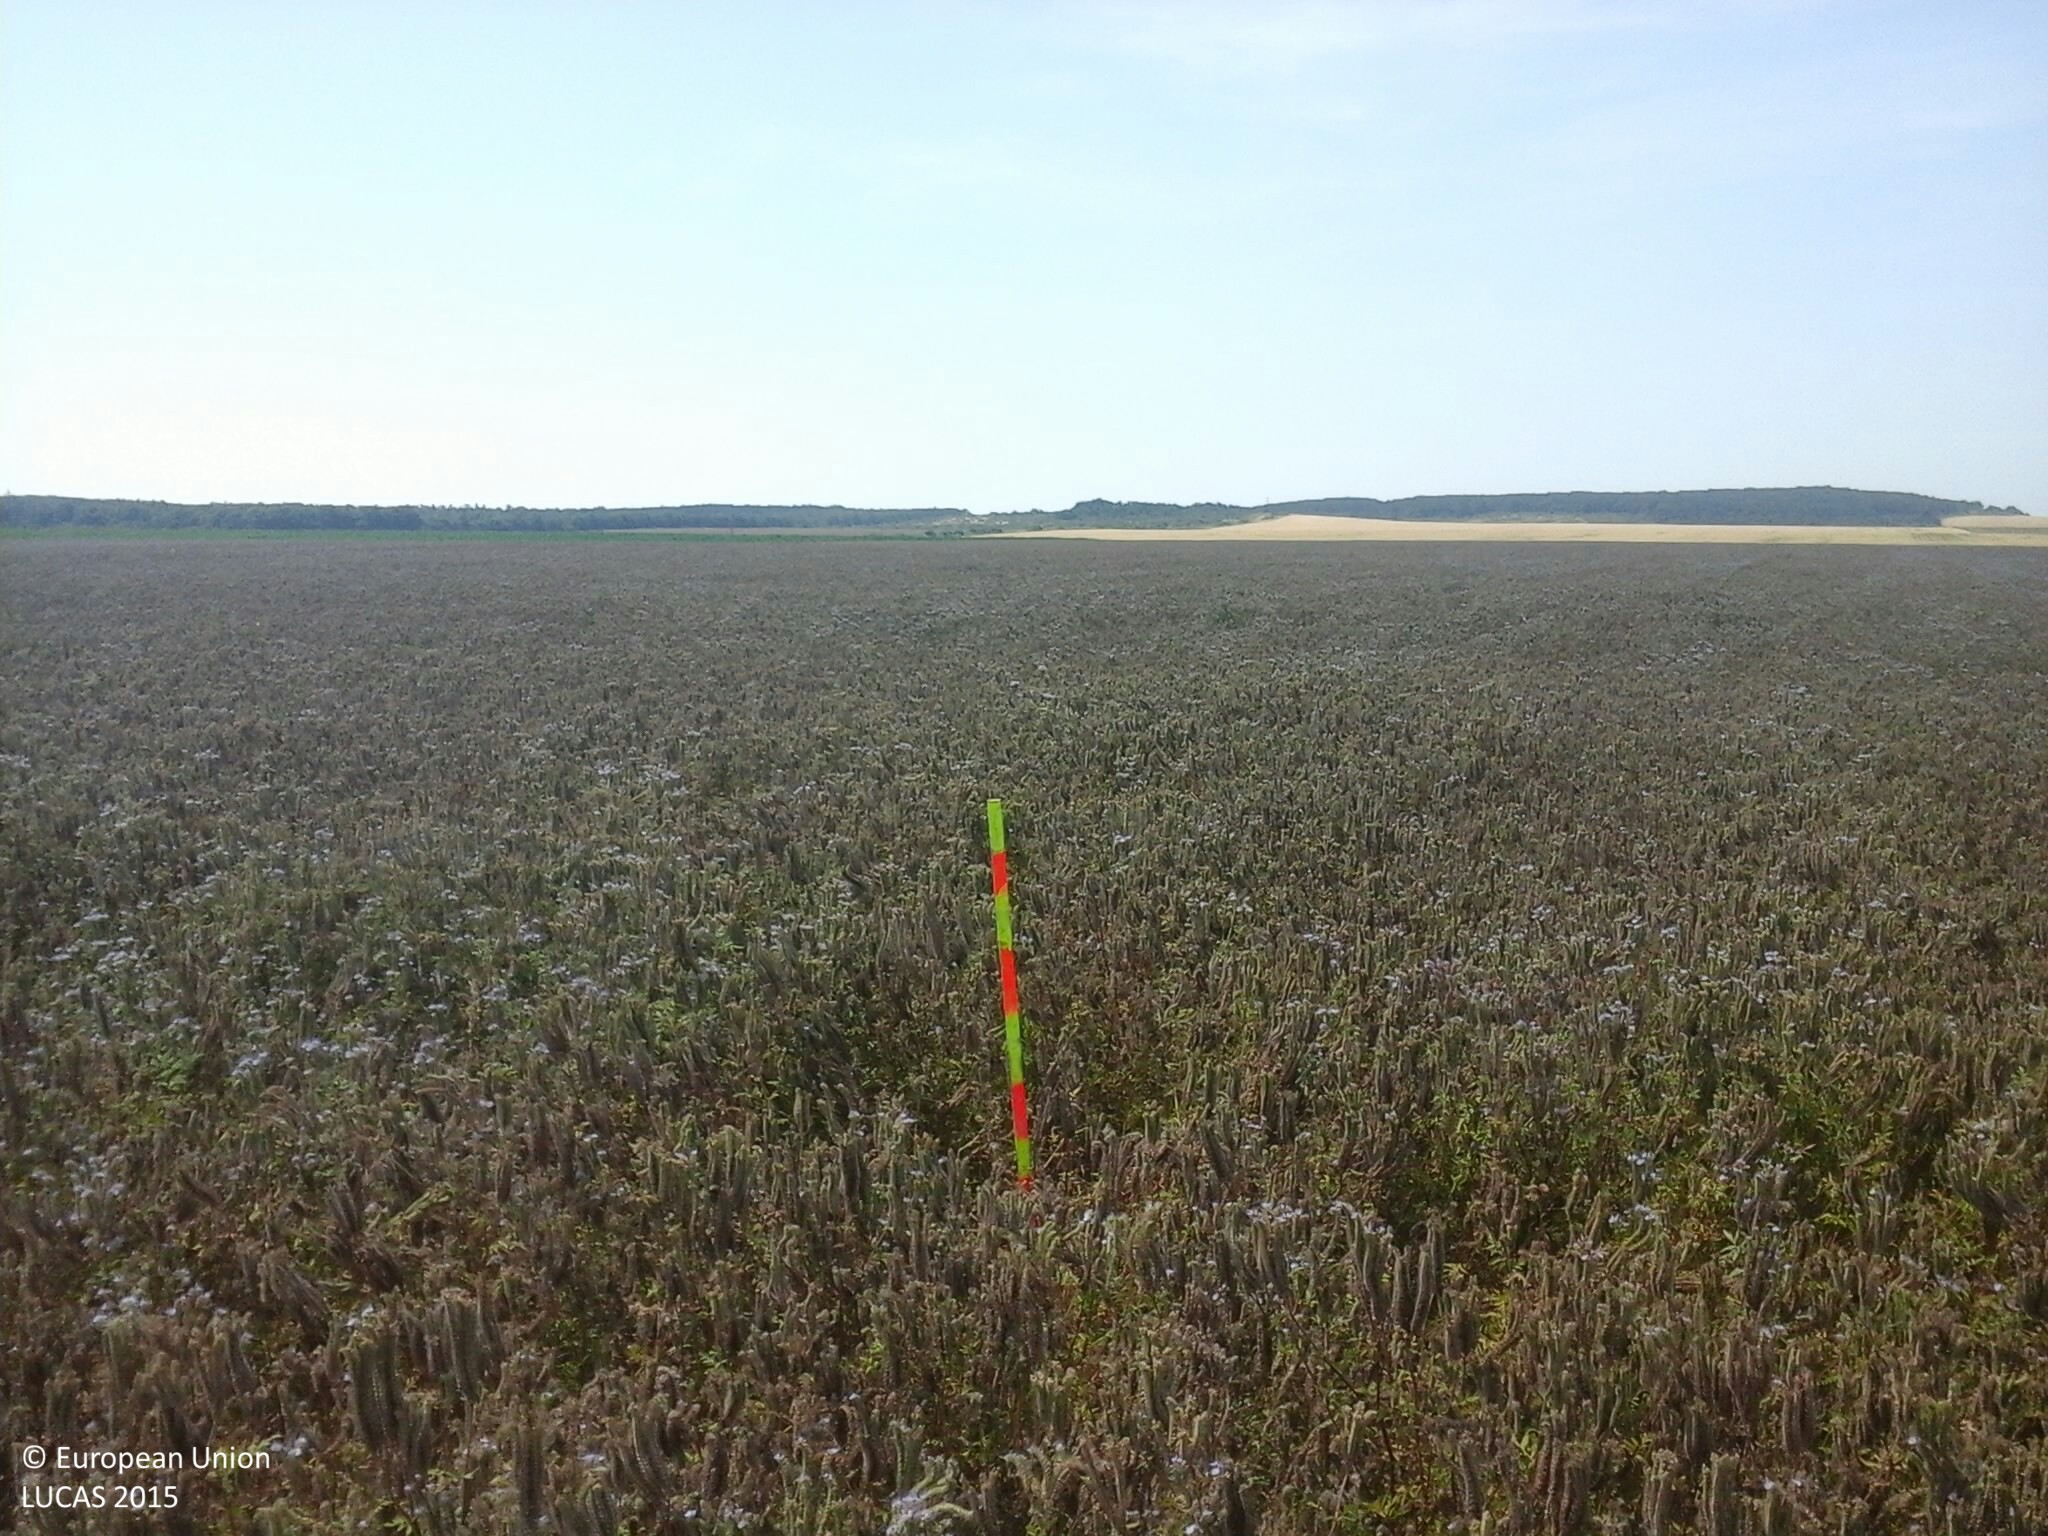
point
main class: Cropland
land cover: Other leguminous and mixtures for fodder
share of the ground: > 75 %
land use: Agriculture (excluding fallow land and kitchen gardens)
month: July
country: HU
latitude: 47.0401
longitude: 17.8392
